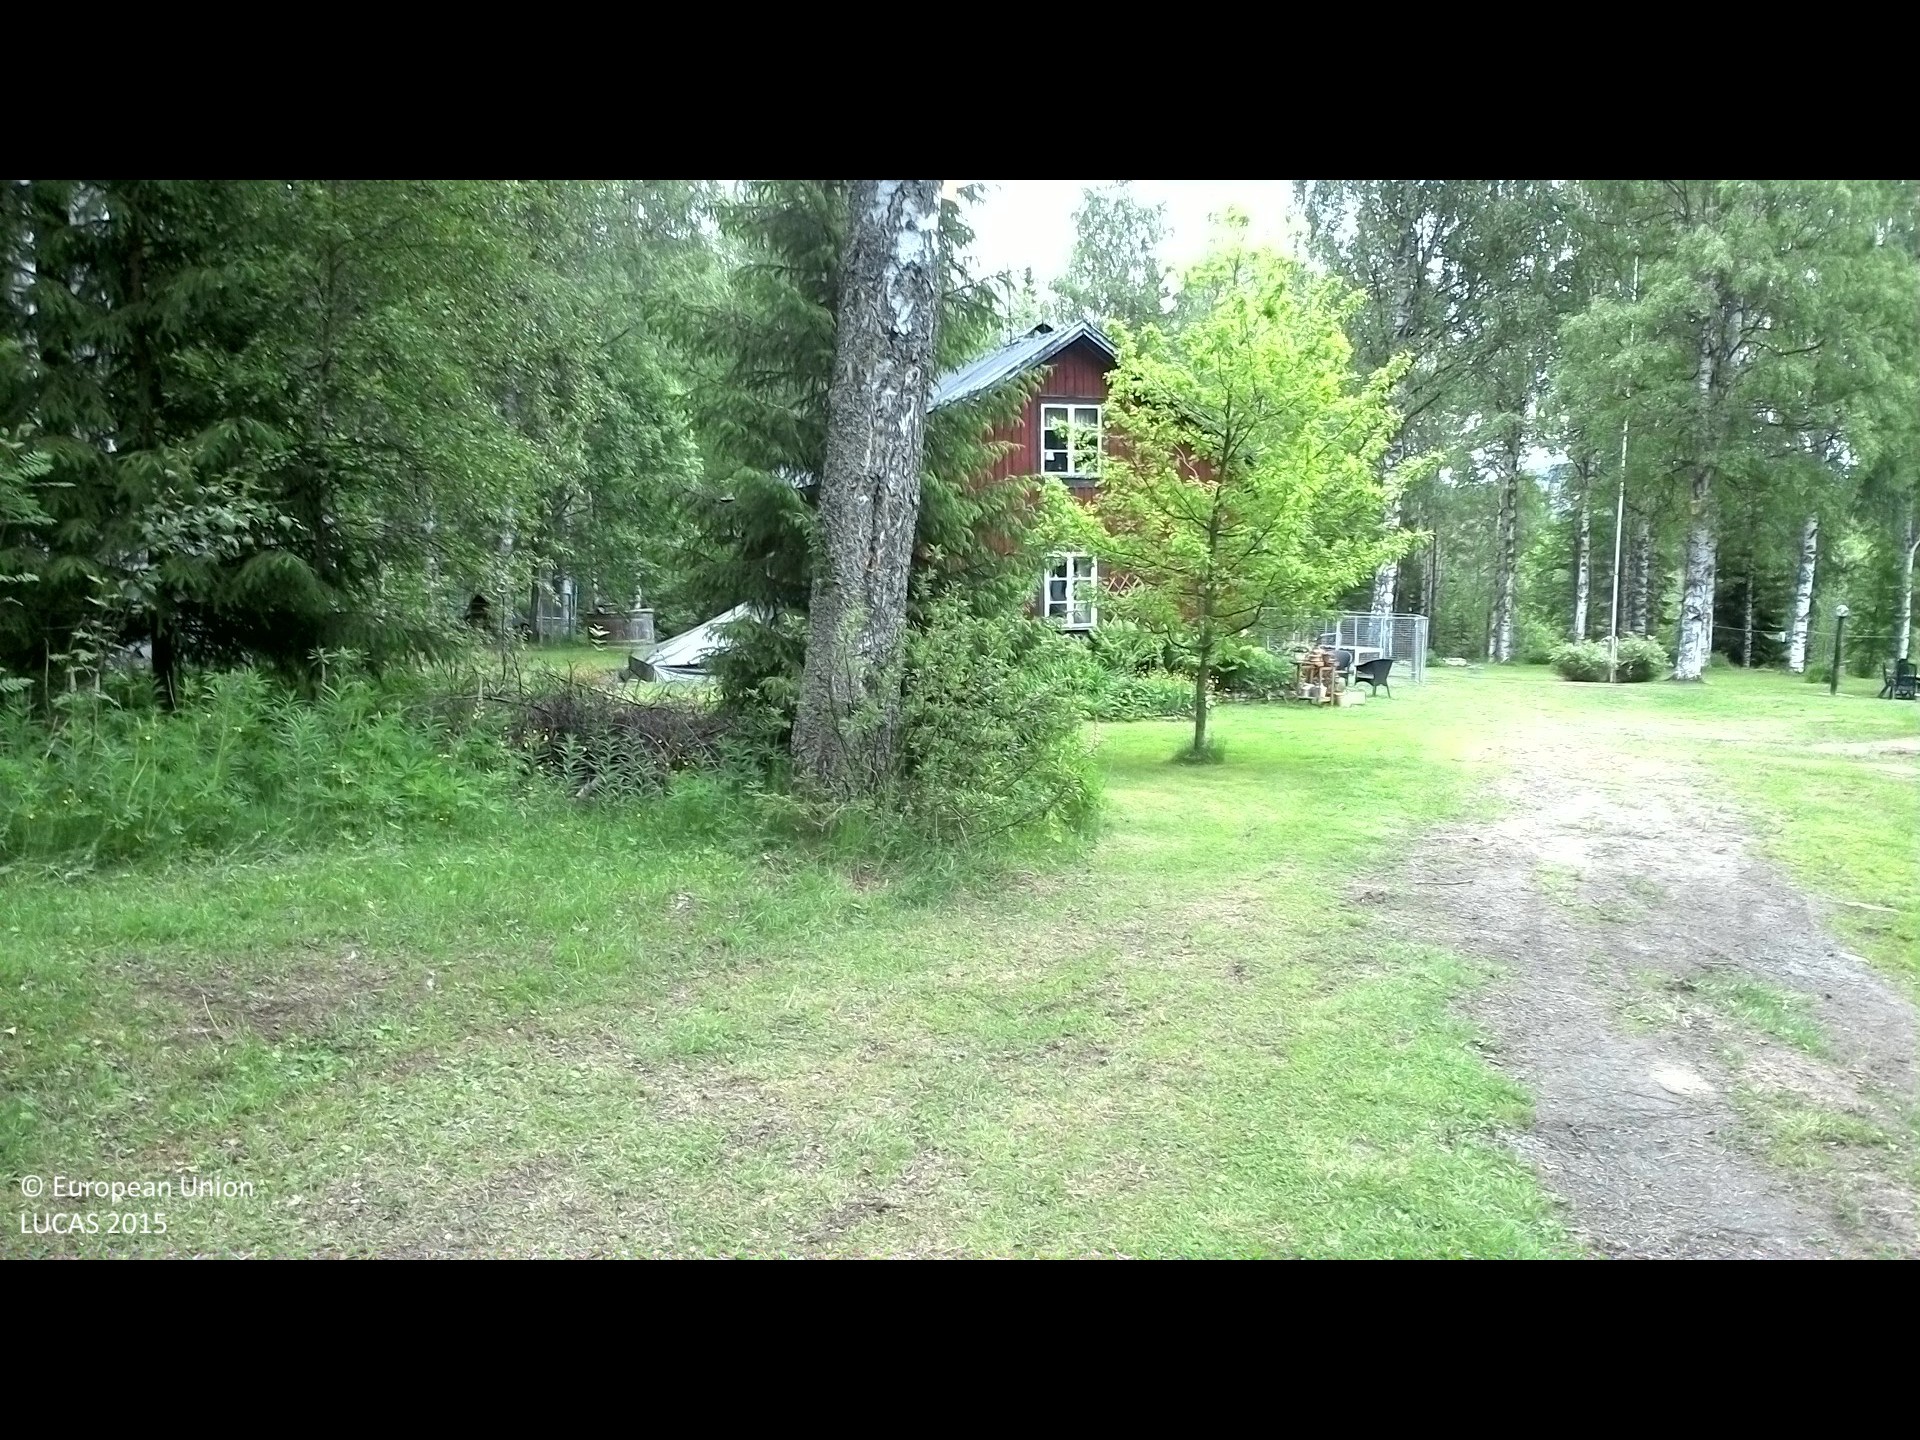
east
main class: Grassland
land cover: Grassland without tree/shrub cover
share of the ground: > 75 %
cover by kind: herbaceous plants 100 %
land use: Residential
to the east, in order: Grassland without tree/shrub cover; Artificial constructions in urban areas; Broadleaved woodland; Rivers and streams; Spruce dominated mixed woodland; Rivers and streams; Artificial constructions in urban areas; Broadleaved woodland
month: June
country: SE
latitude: 62.0426
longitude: 16.3868
